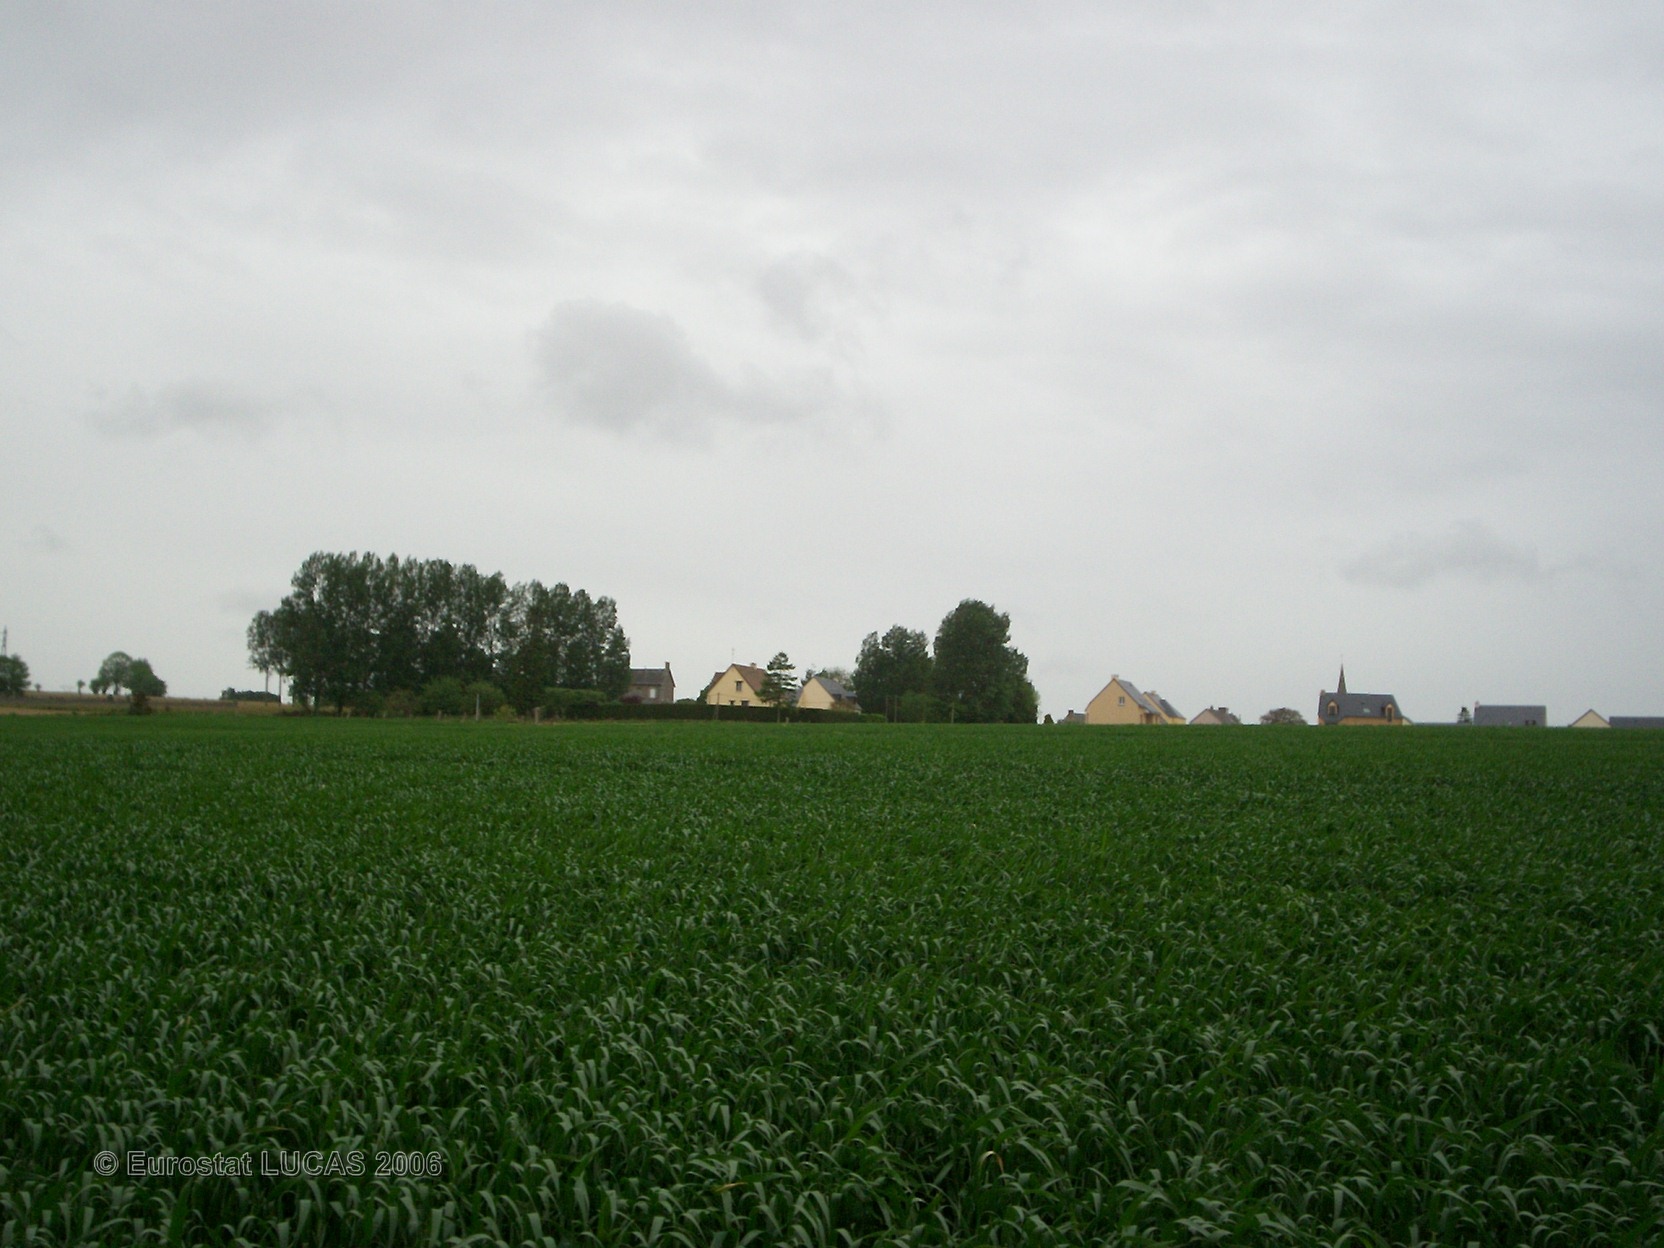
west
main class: Cropland
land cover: Common wheat
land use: Agriculture (excluding fallow land and kitchen gardens)
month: May
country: FR
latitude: 48.5719
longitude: -1.2523
